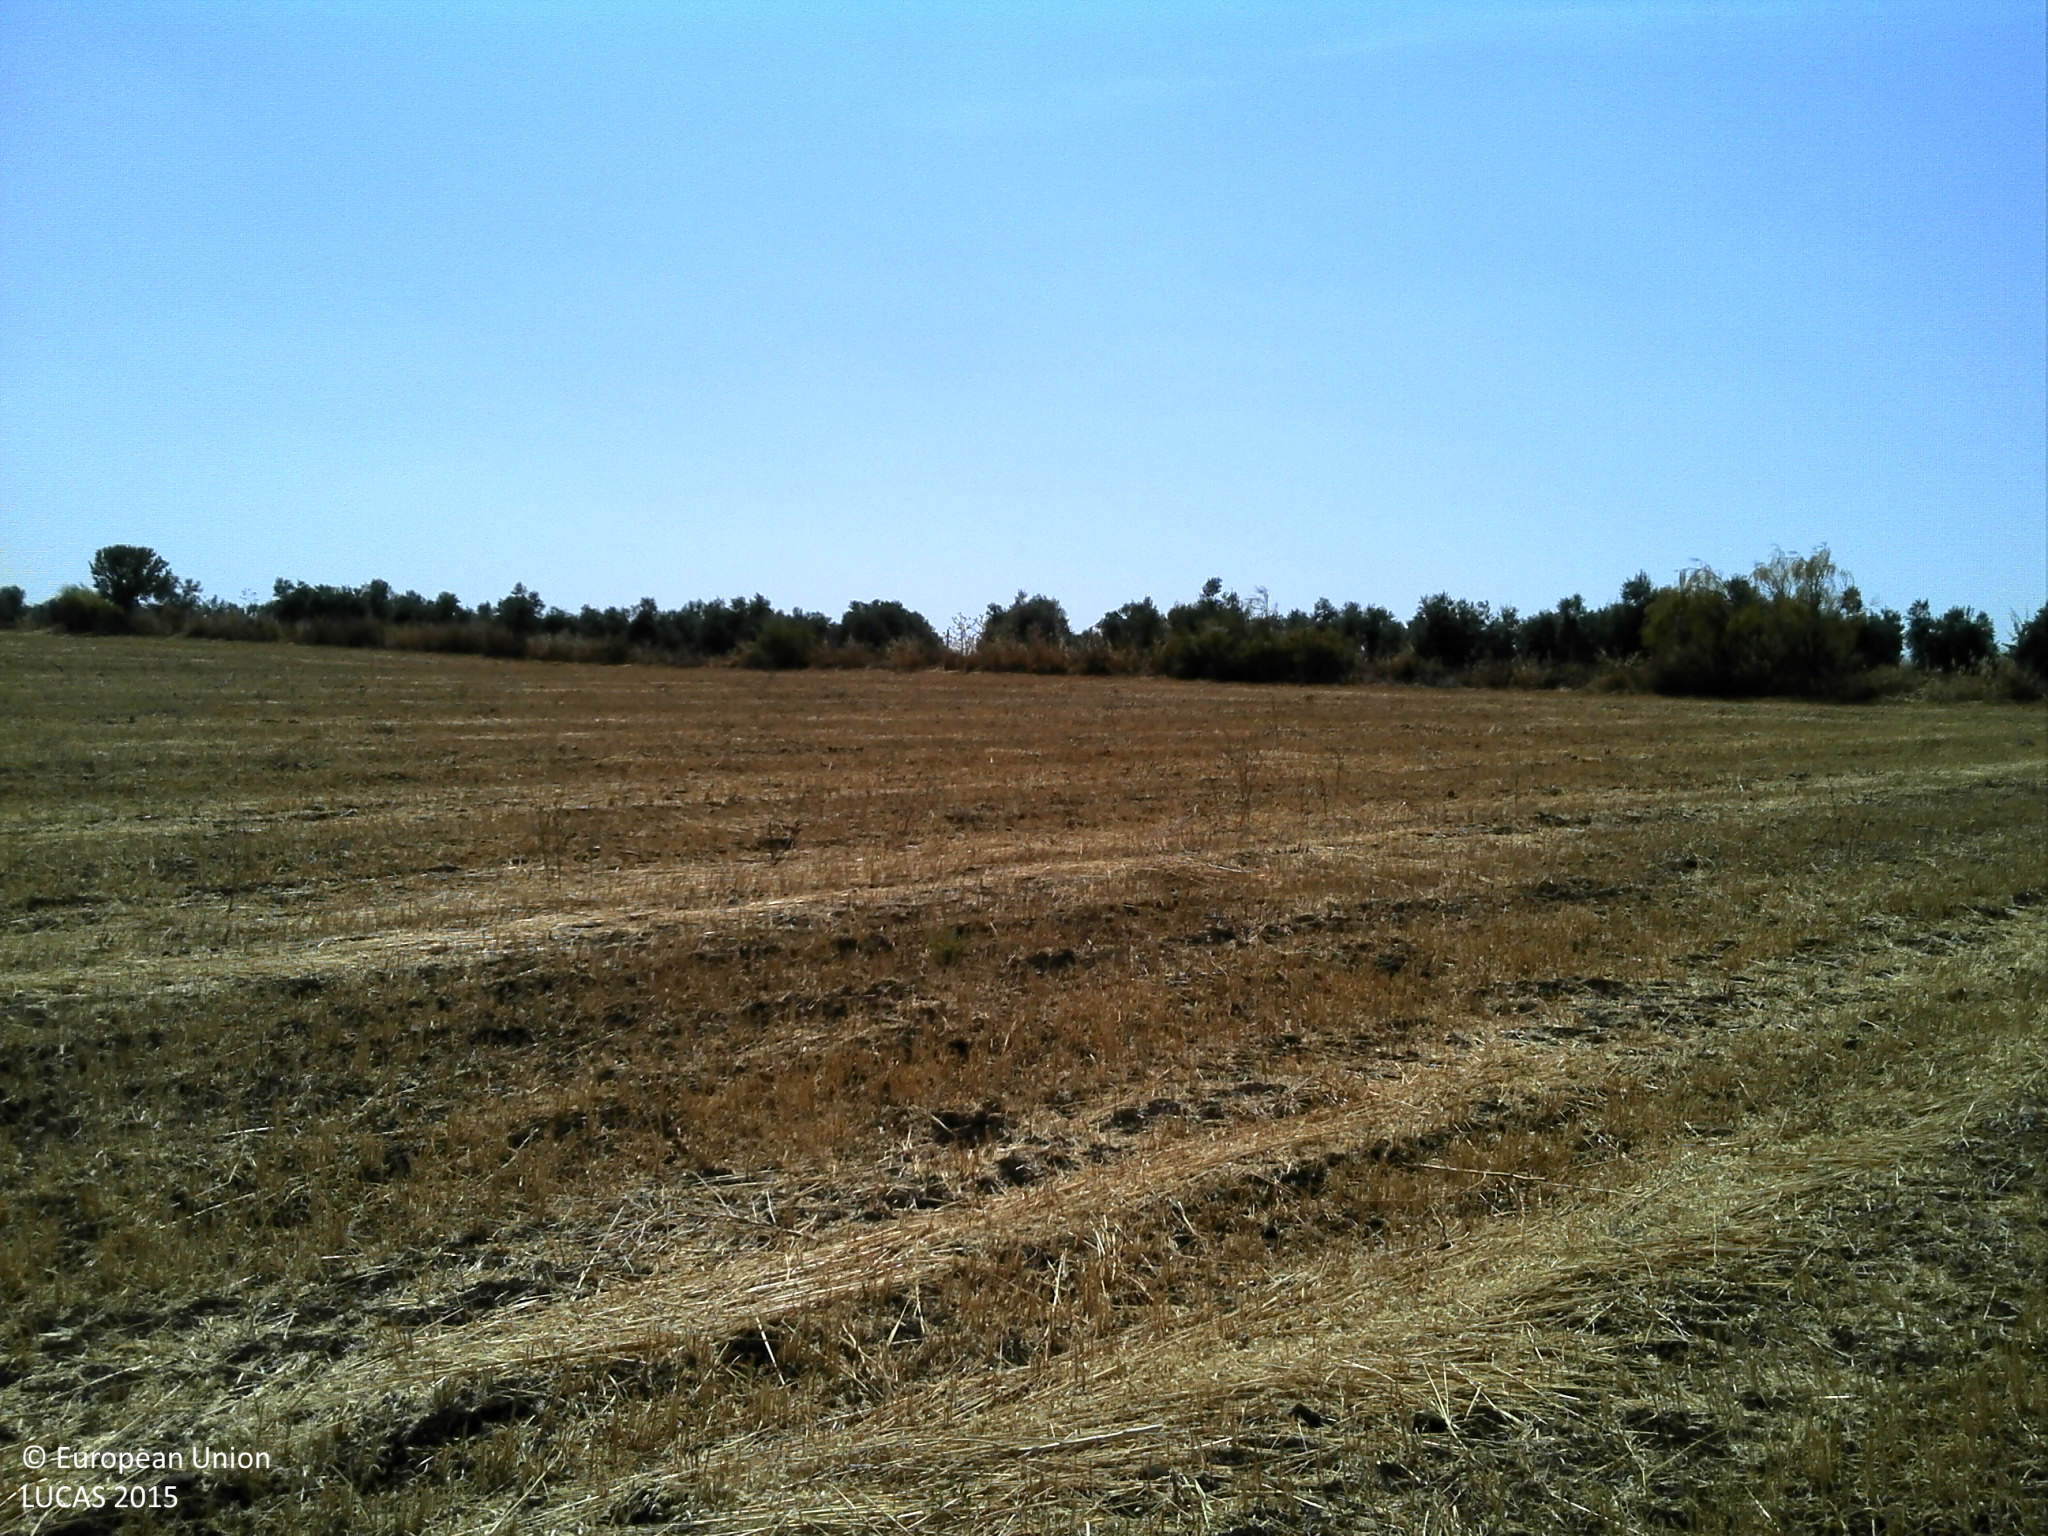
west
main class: Cropland
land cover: Oats
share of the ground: 10 - 25 %
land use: Agriculture (excluding fallow land and kitchen gardens)
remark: Harvested field
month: July
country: PT
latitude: 38.5740
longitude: -7.6759
